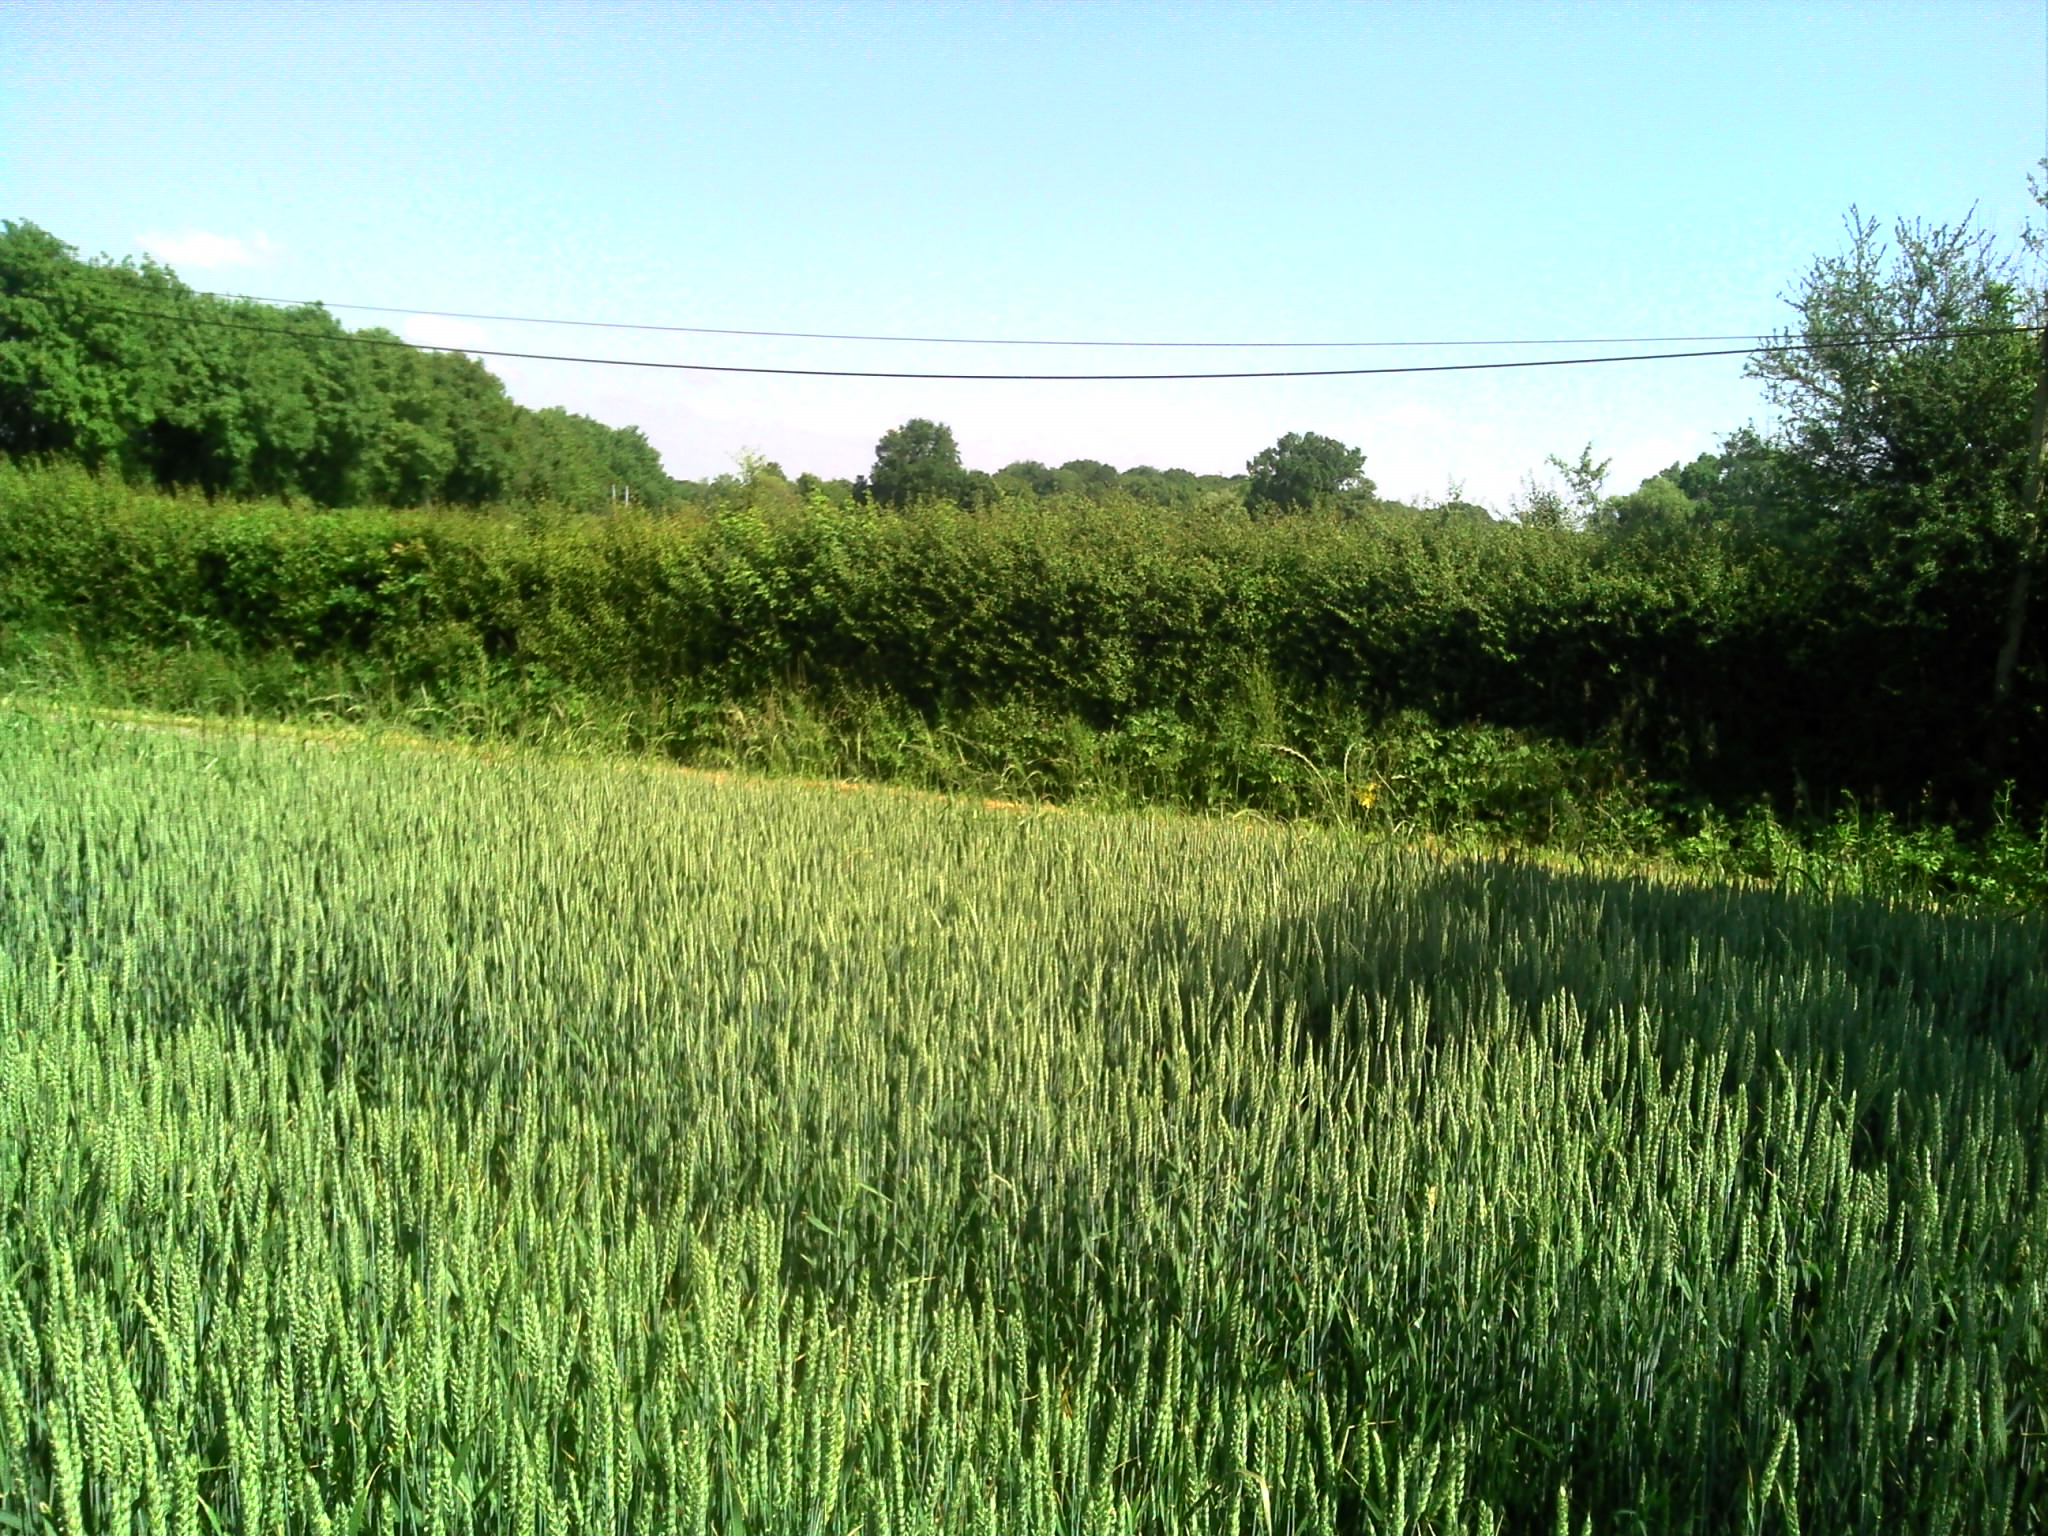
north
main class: Cropland
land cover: Common wheat
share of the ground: > 75 %
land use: Agriculture (excluding fallow land and kitchen gardens)
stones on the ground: < 10 %
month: May
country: FR
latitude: 46.5259
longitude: 5.0613
